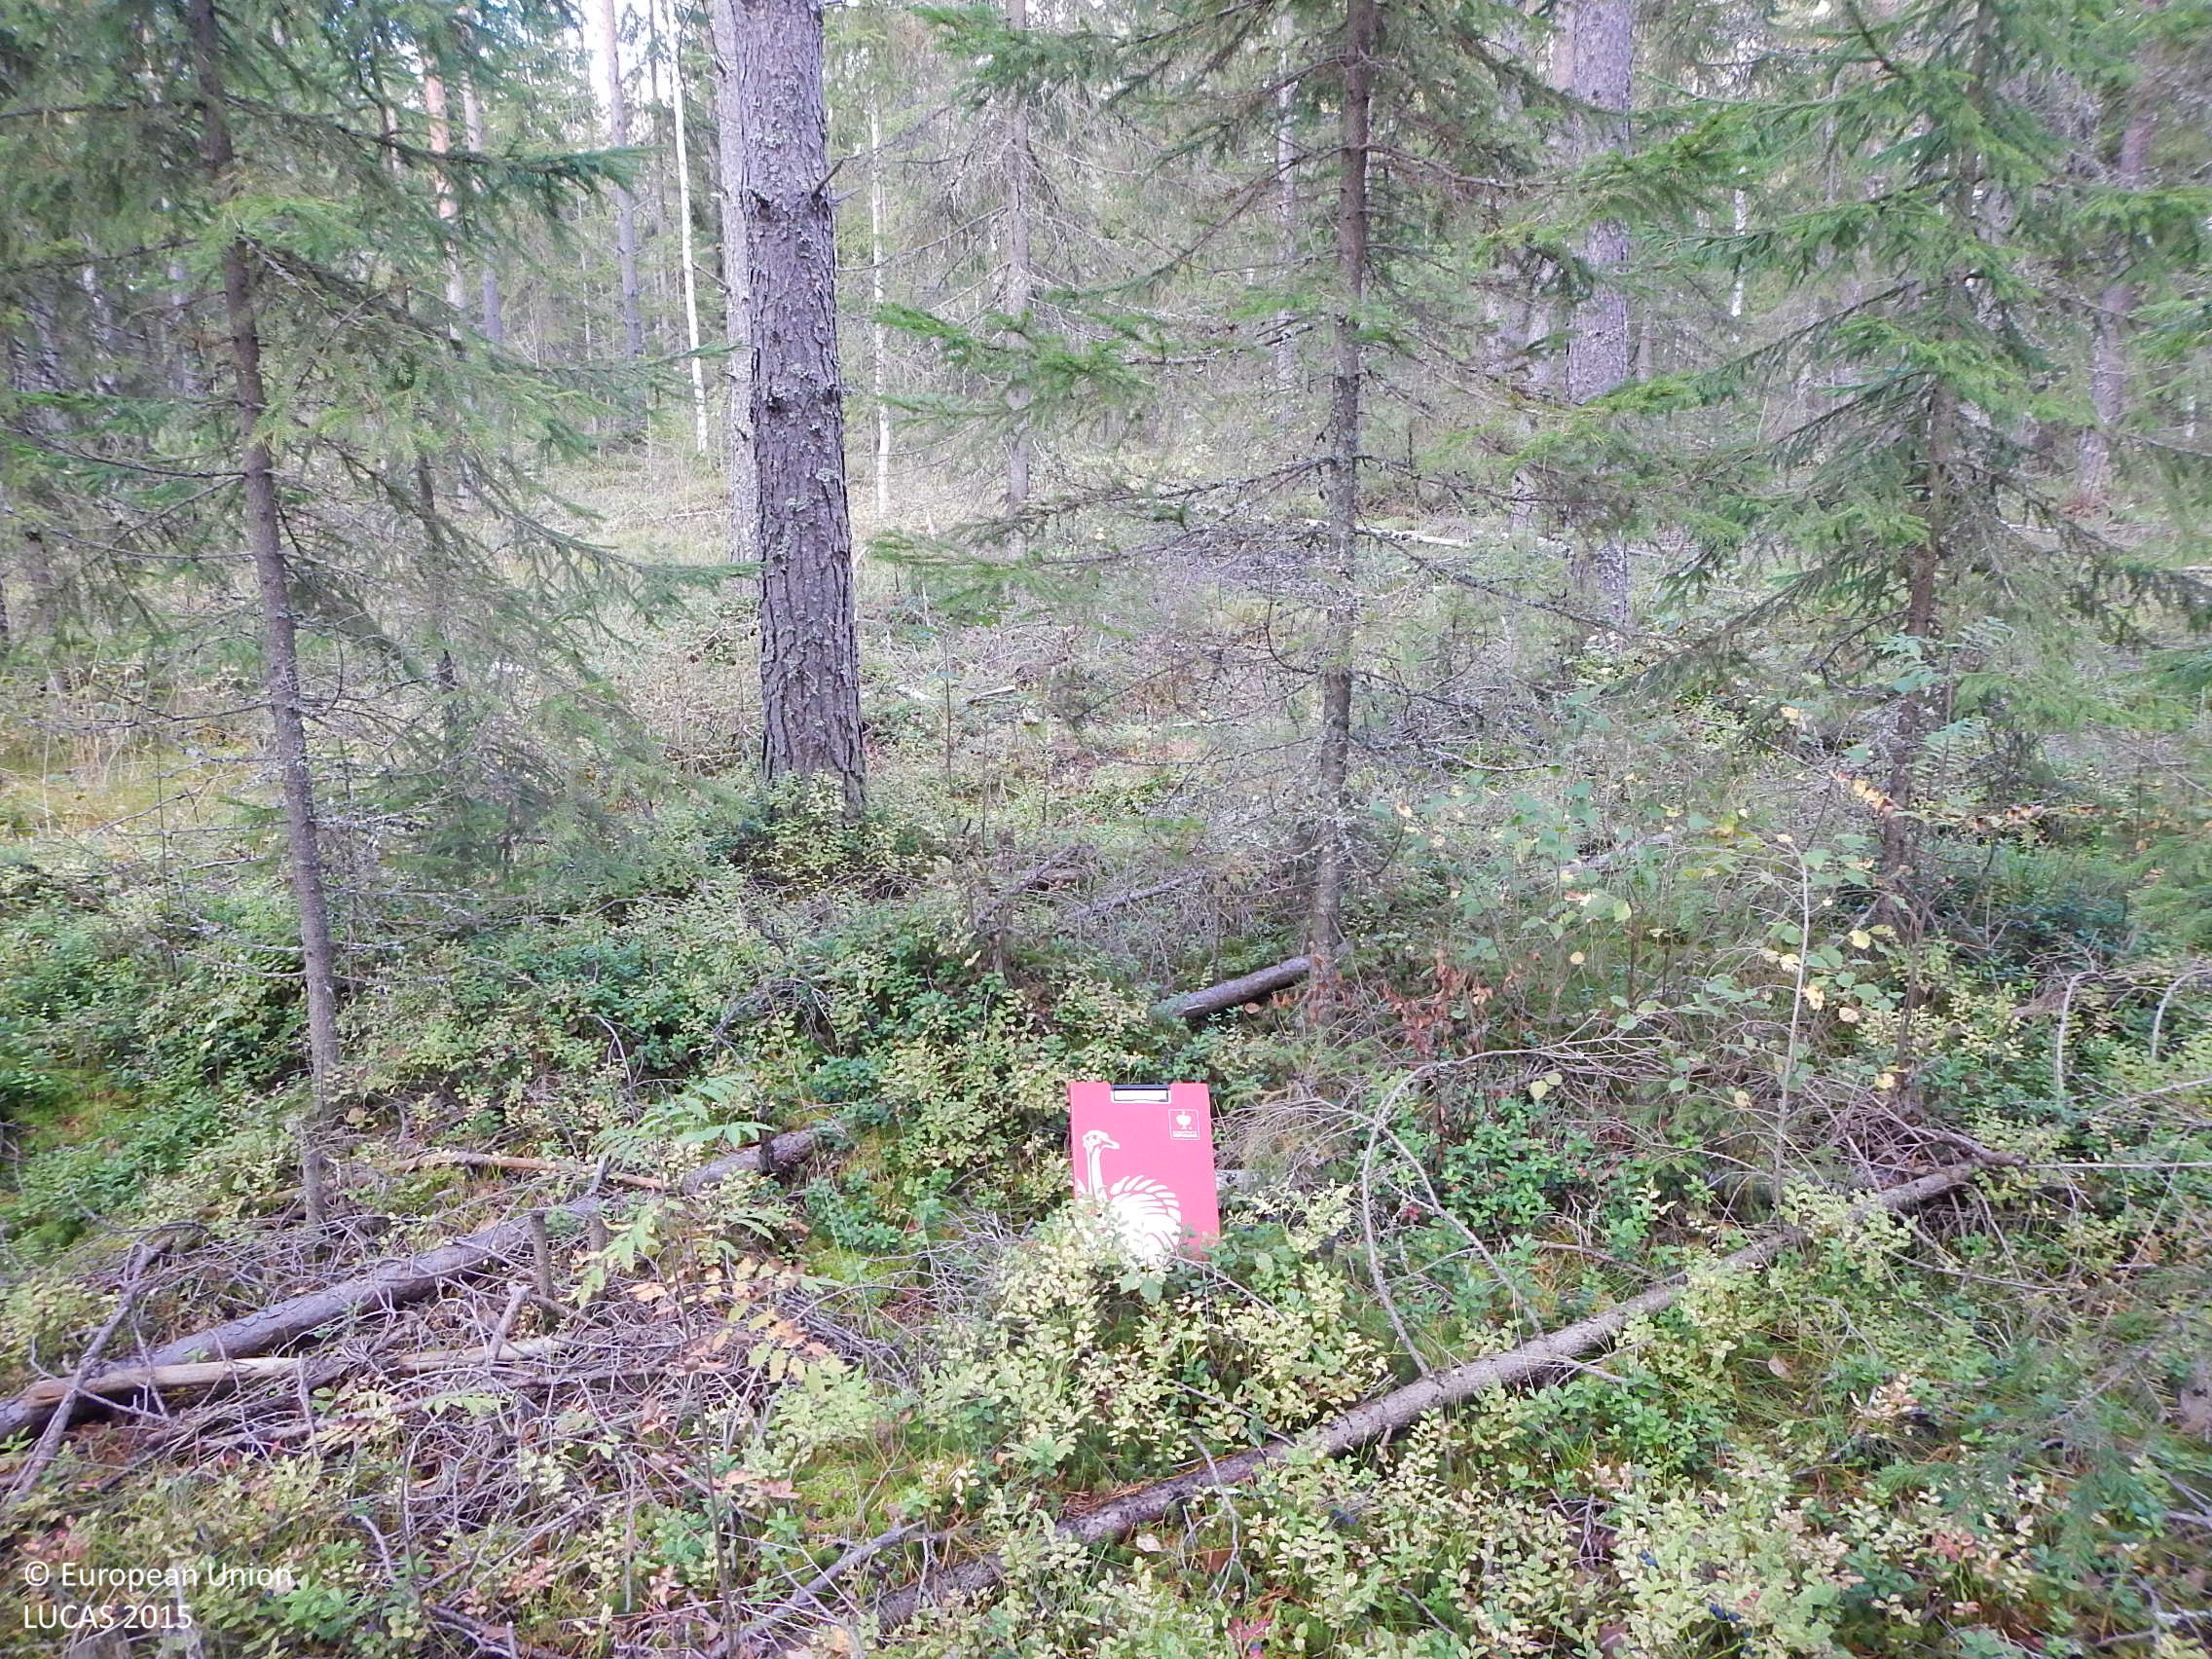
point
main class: Woodland
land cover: Other mixed woodland
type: boreal forest
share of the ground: > 75 %
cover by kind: coniferous forest trees 55 %, broadleaved forest trees 25 %, shrubs 20 %
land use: Forestry
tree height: > 5 m
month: September
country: FI
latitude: 61.9551
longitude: 22.7810
